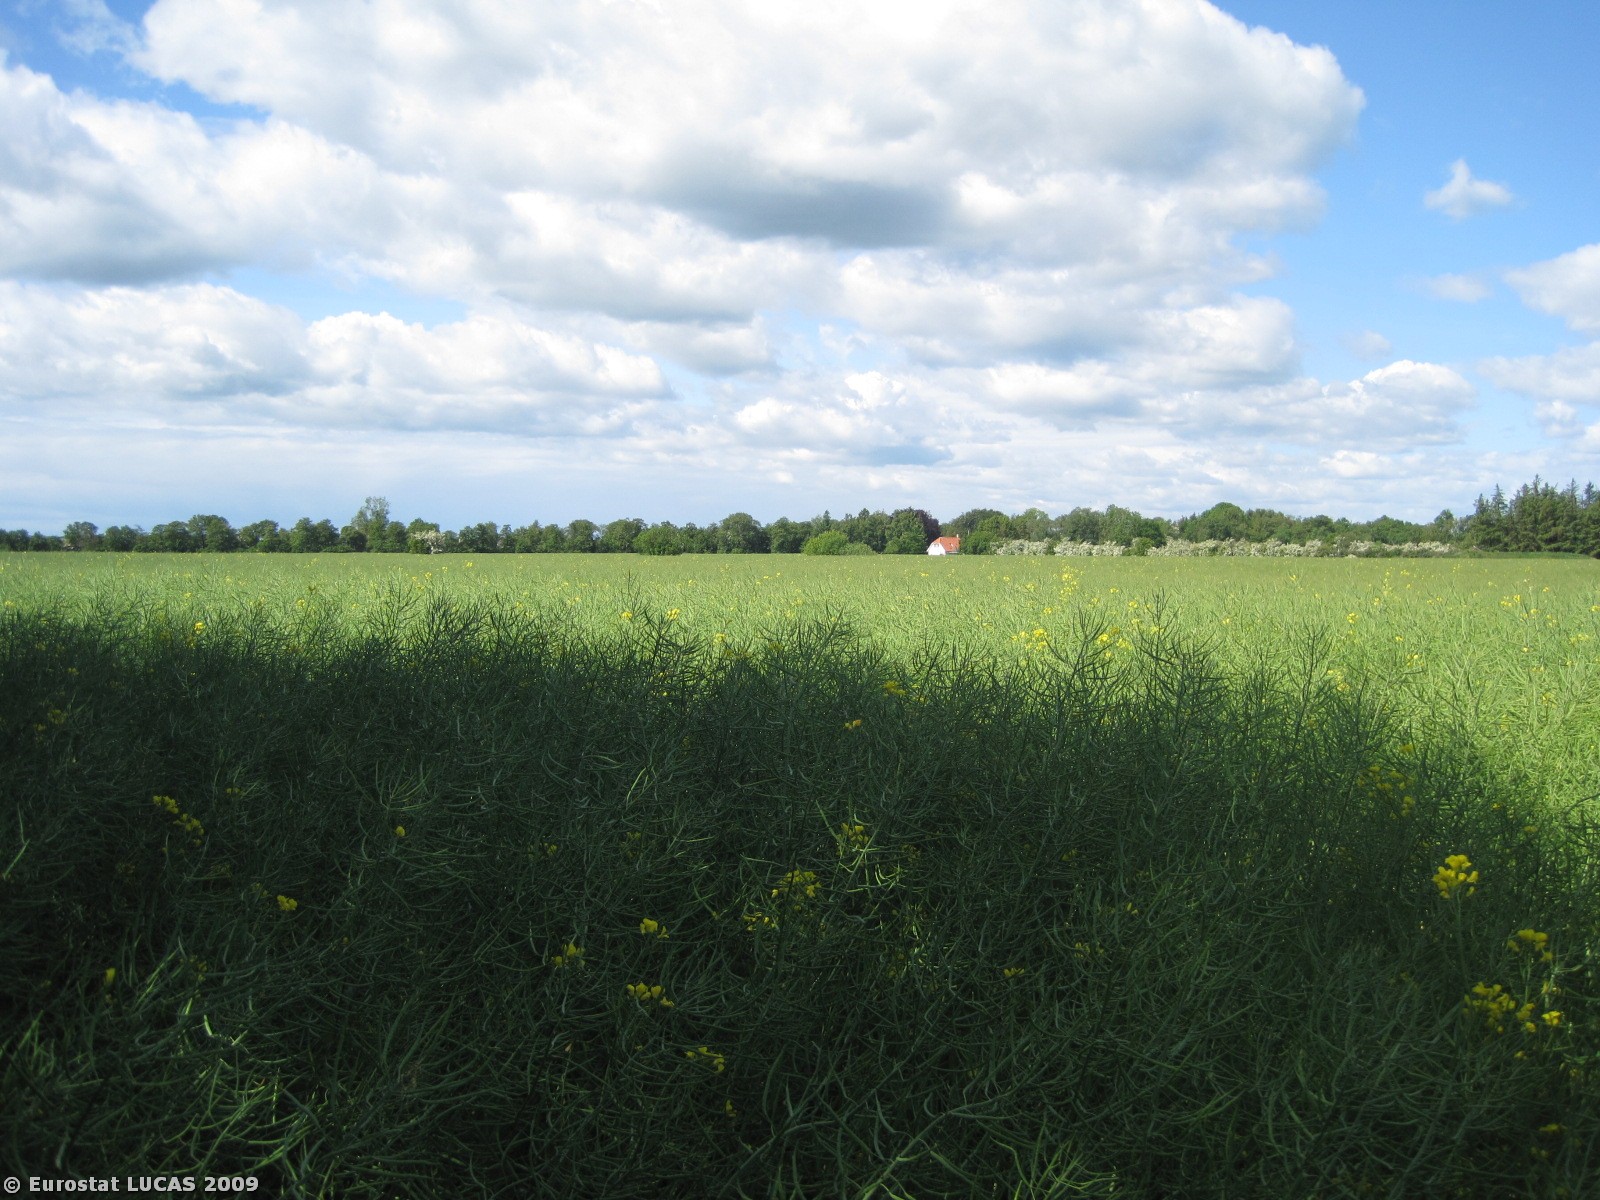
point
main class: Cropland
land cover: Rape and turnip rape
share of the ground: > 75 %
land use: Agriculture (excluding fallow land and kitchen gardens)
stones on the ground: < 10 %
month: June
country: DK
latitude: 56.9426
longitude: 10.2134
